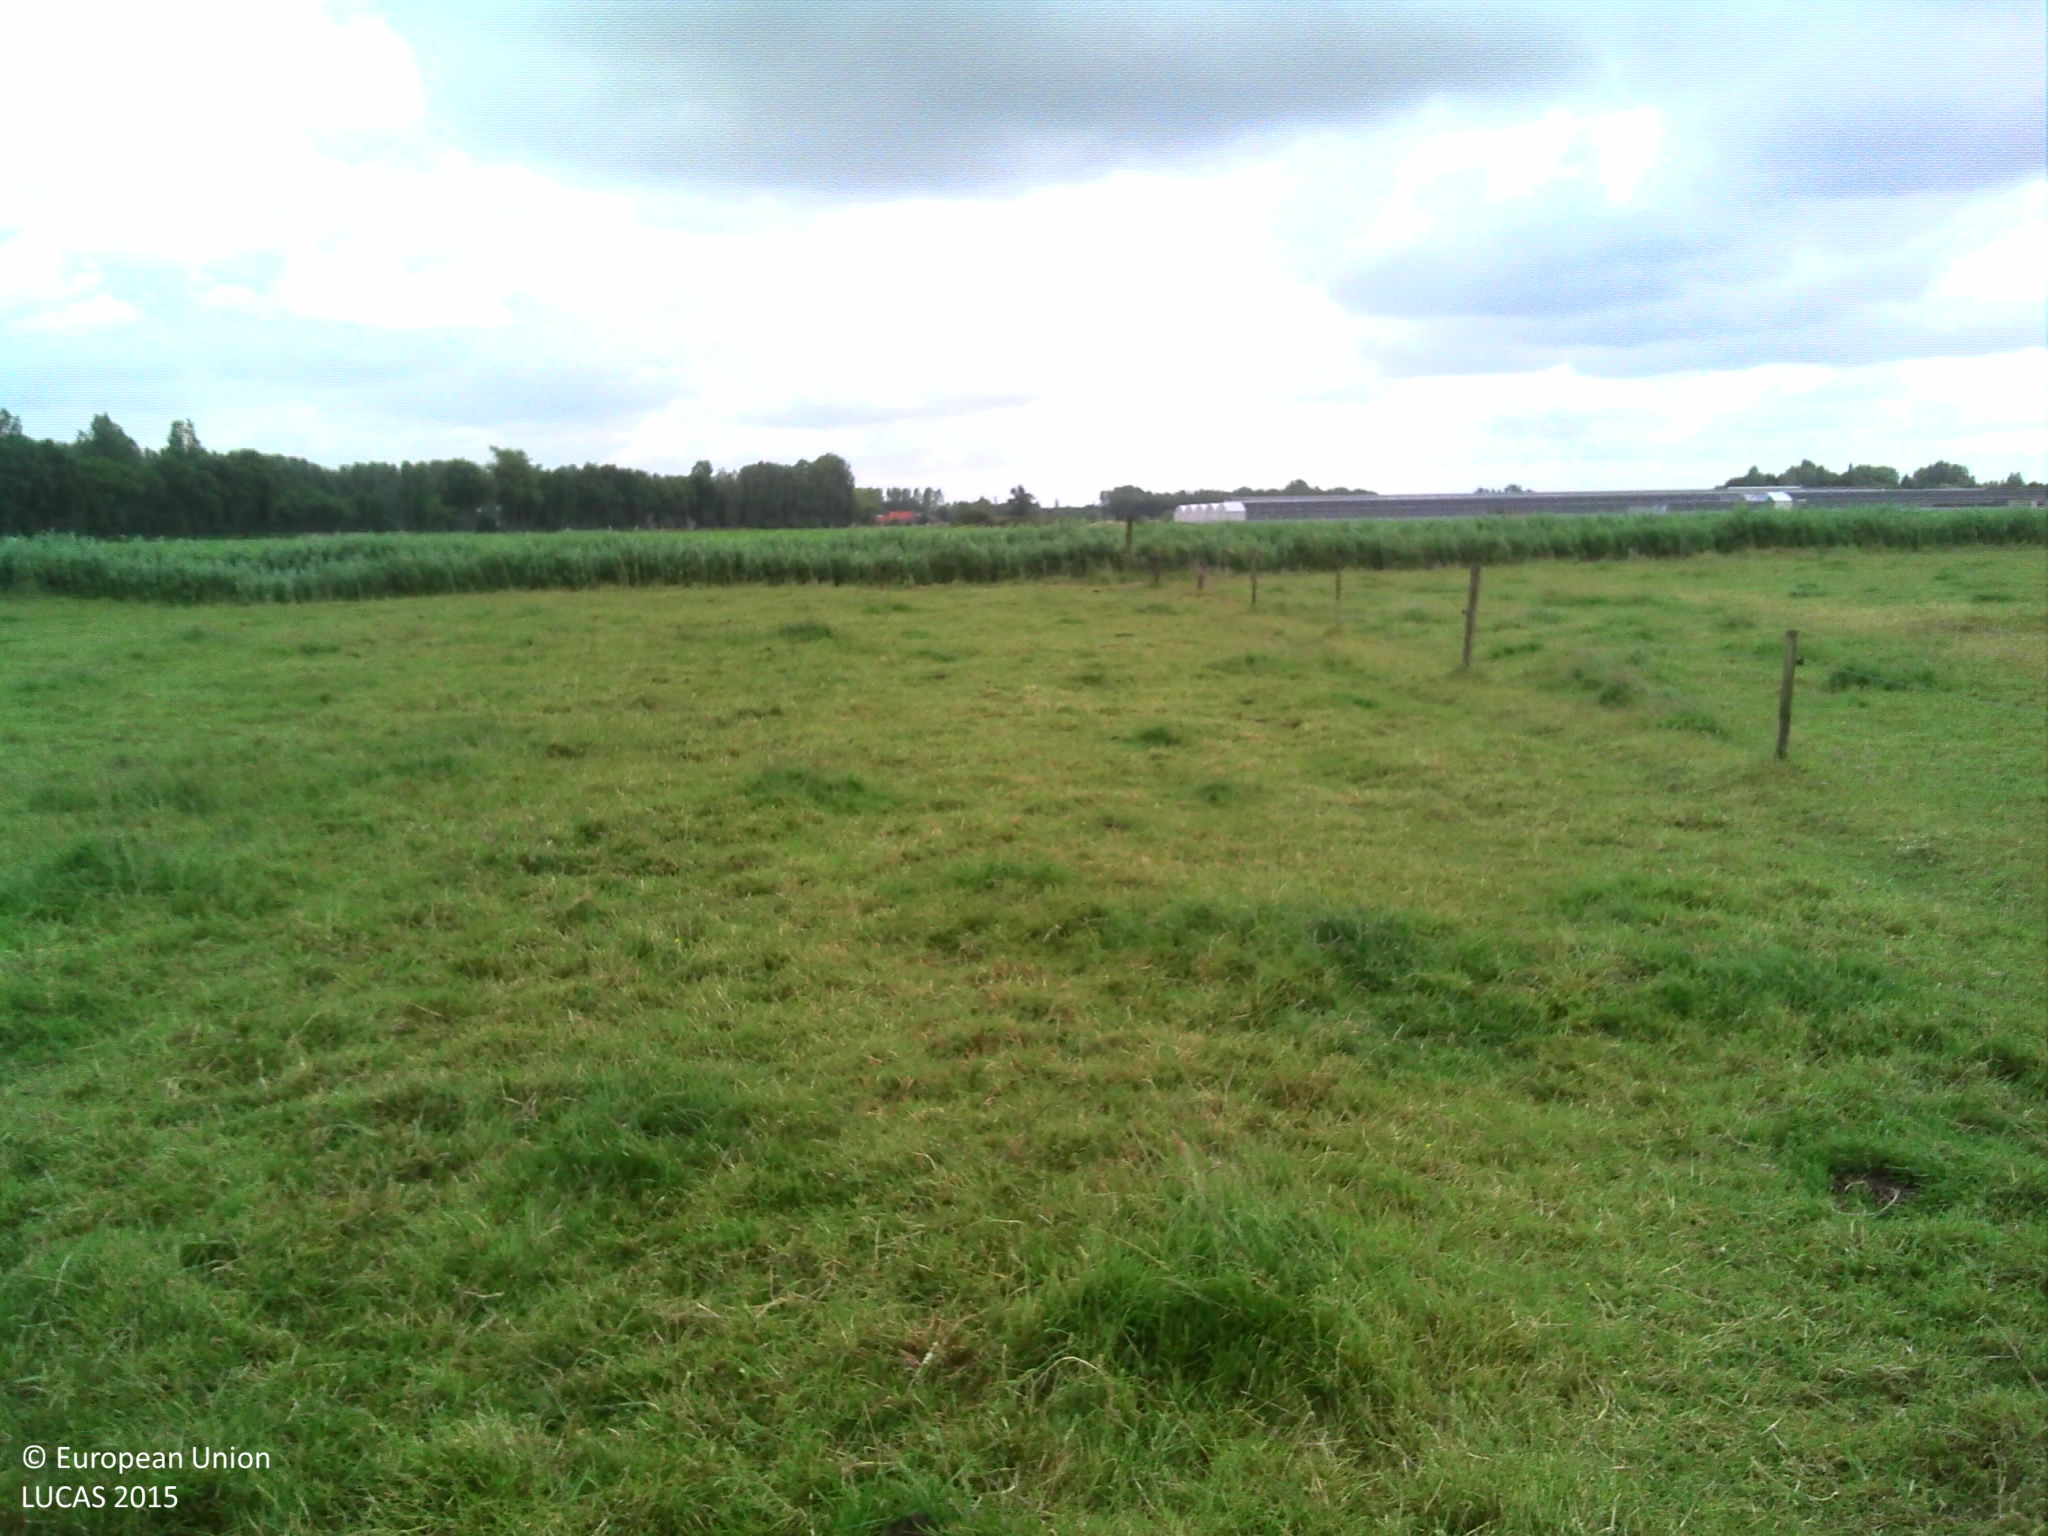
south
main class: Grassland
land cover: Grassland without tree/shrub cover
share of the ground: > 75 %
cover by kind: herbaceous plants 100 %
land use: Agriculture (excluding fallow land and kitchen gardens)
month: June
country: BE
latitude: 51.1951
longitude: 3.9408
